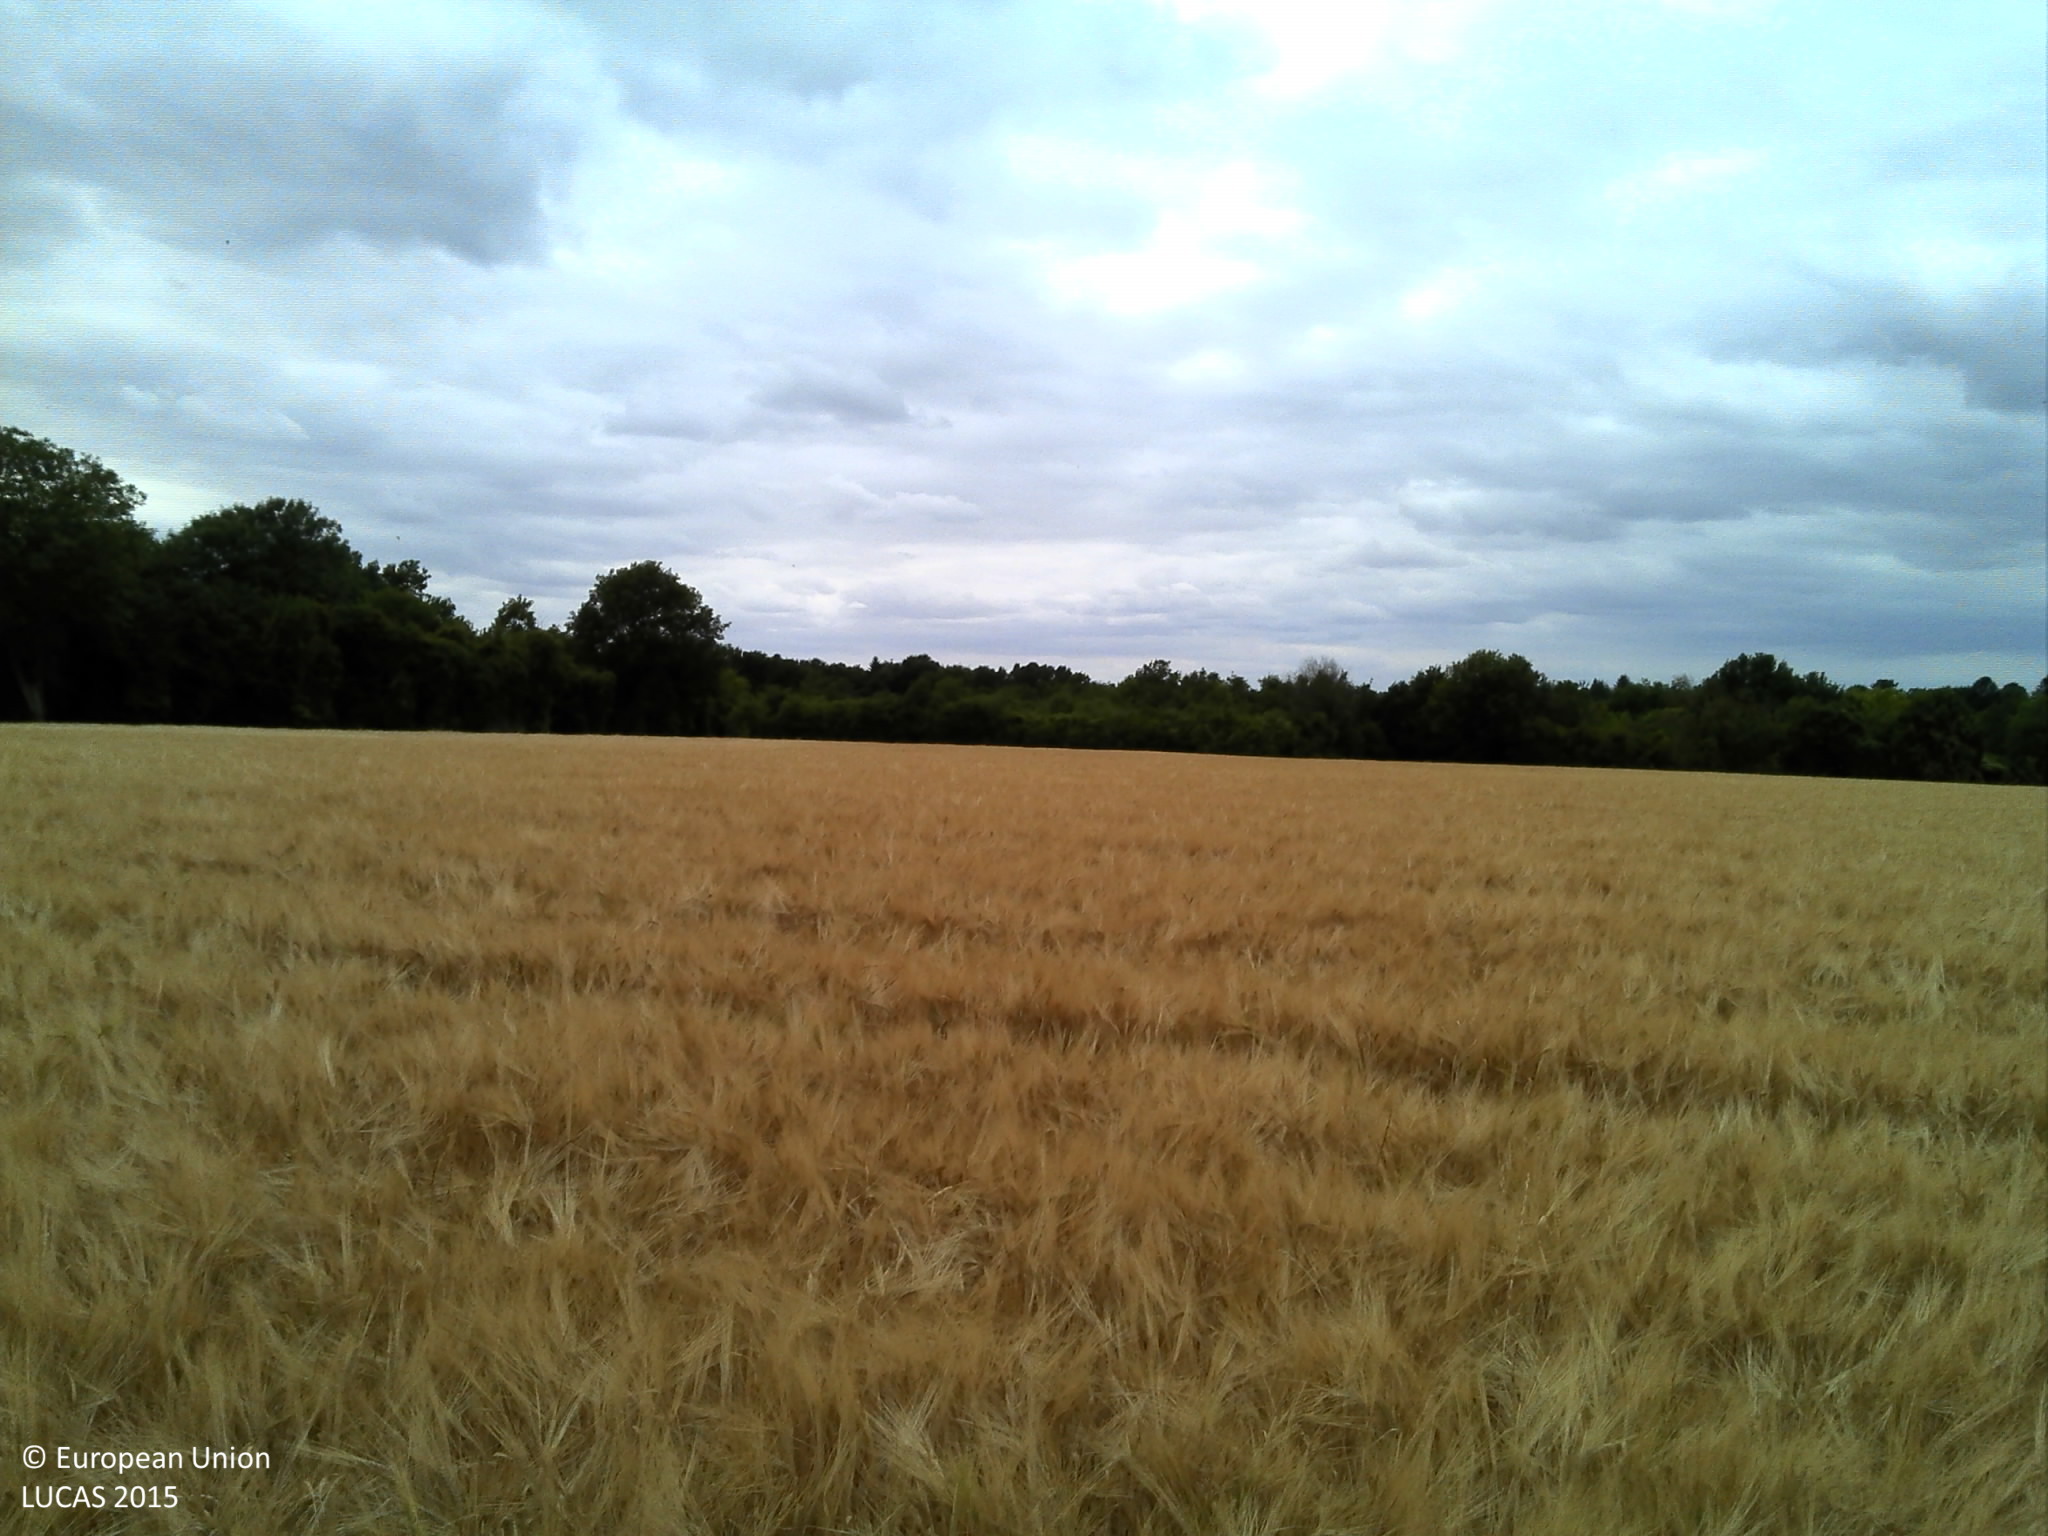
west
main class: Cropland
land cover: Barley
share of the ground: > 75 %
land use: Agriculture (excluding fallow land and kitchen gardens)
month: July
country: FR
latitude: 48.4868
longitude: 2.4256
